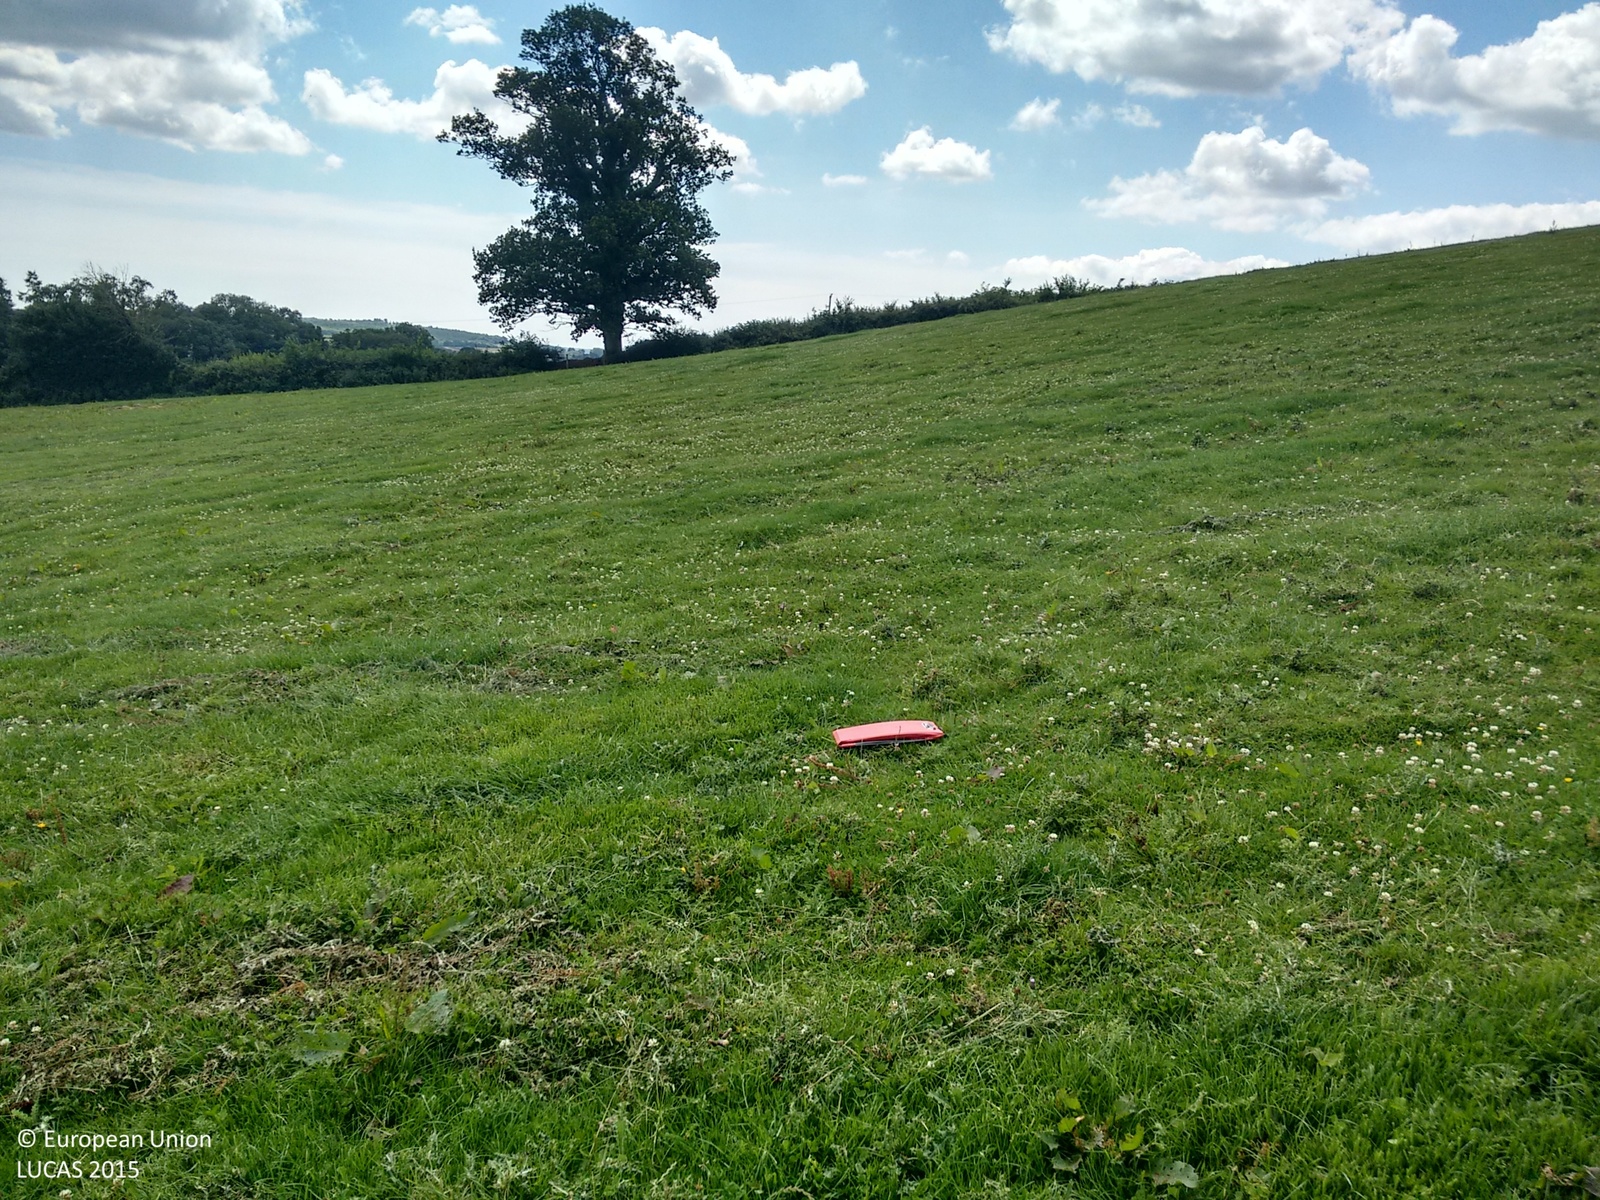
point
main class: Grassland
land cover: Grassland without tree/shrub cover
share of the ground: > 75 %
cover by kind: herbaceous plants 100 %
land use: Agriculture (excluding fallow land and kitchen gardens)
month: July
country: GB
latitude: 50.8243
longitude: -3.4414
